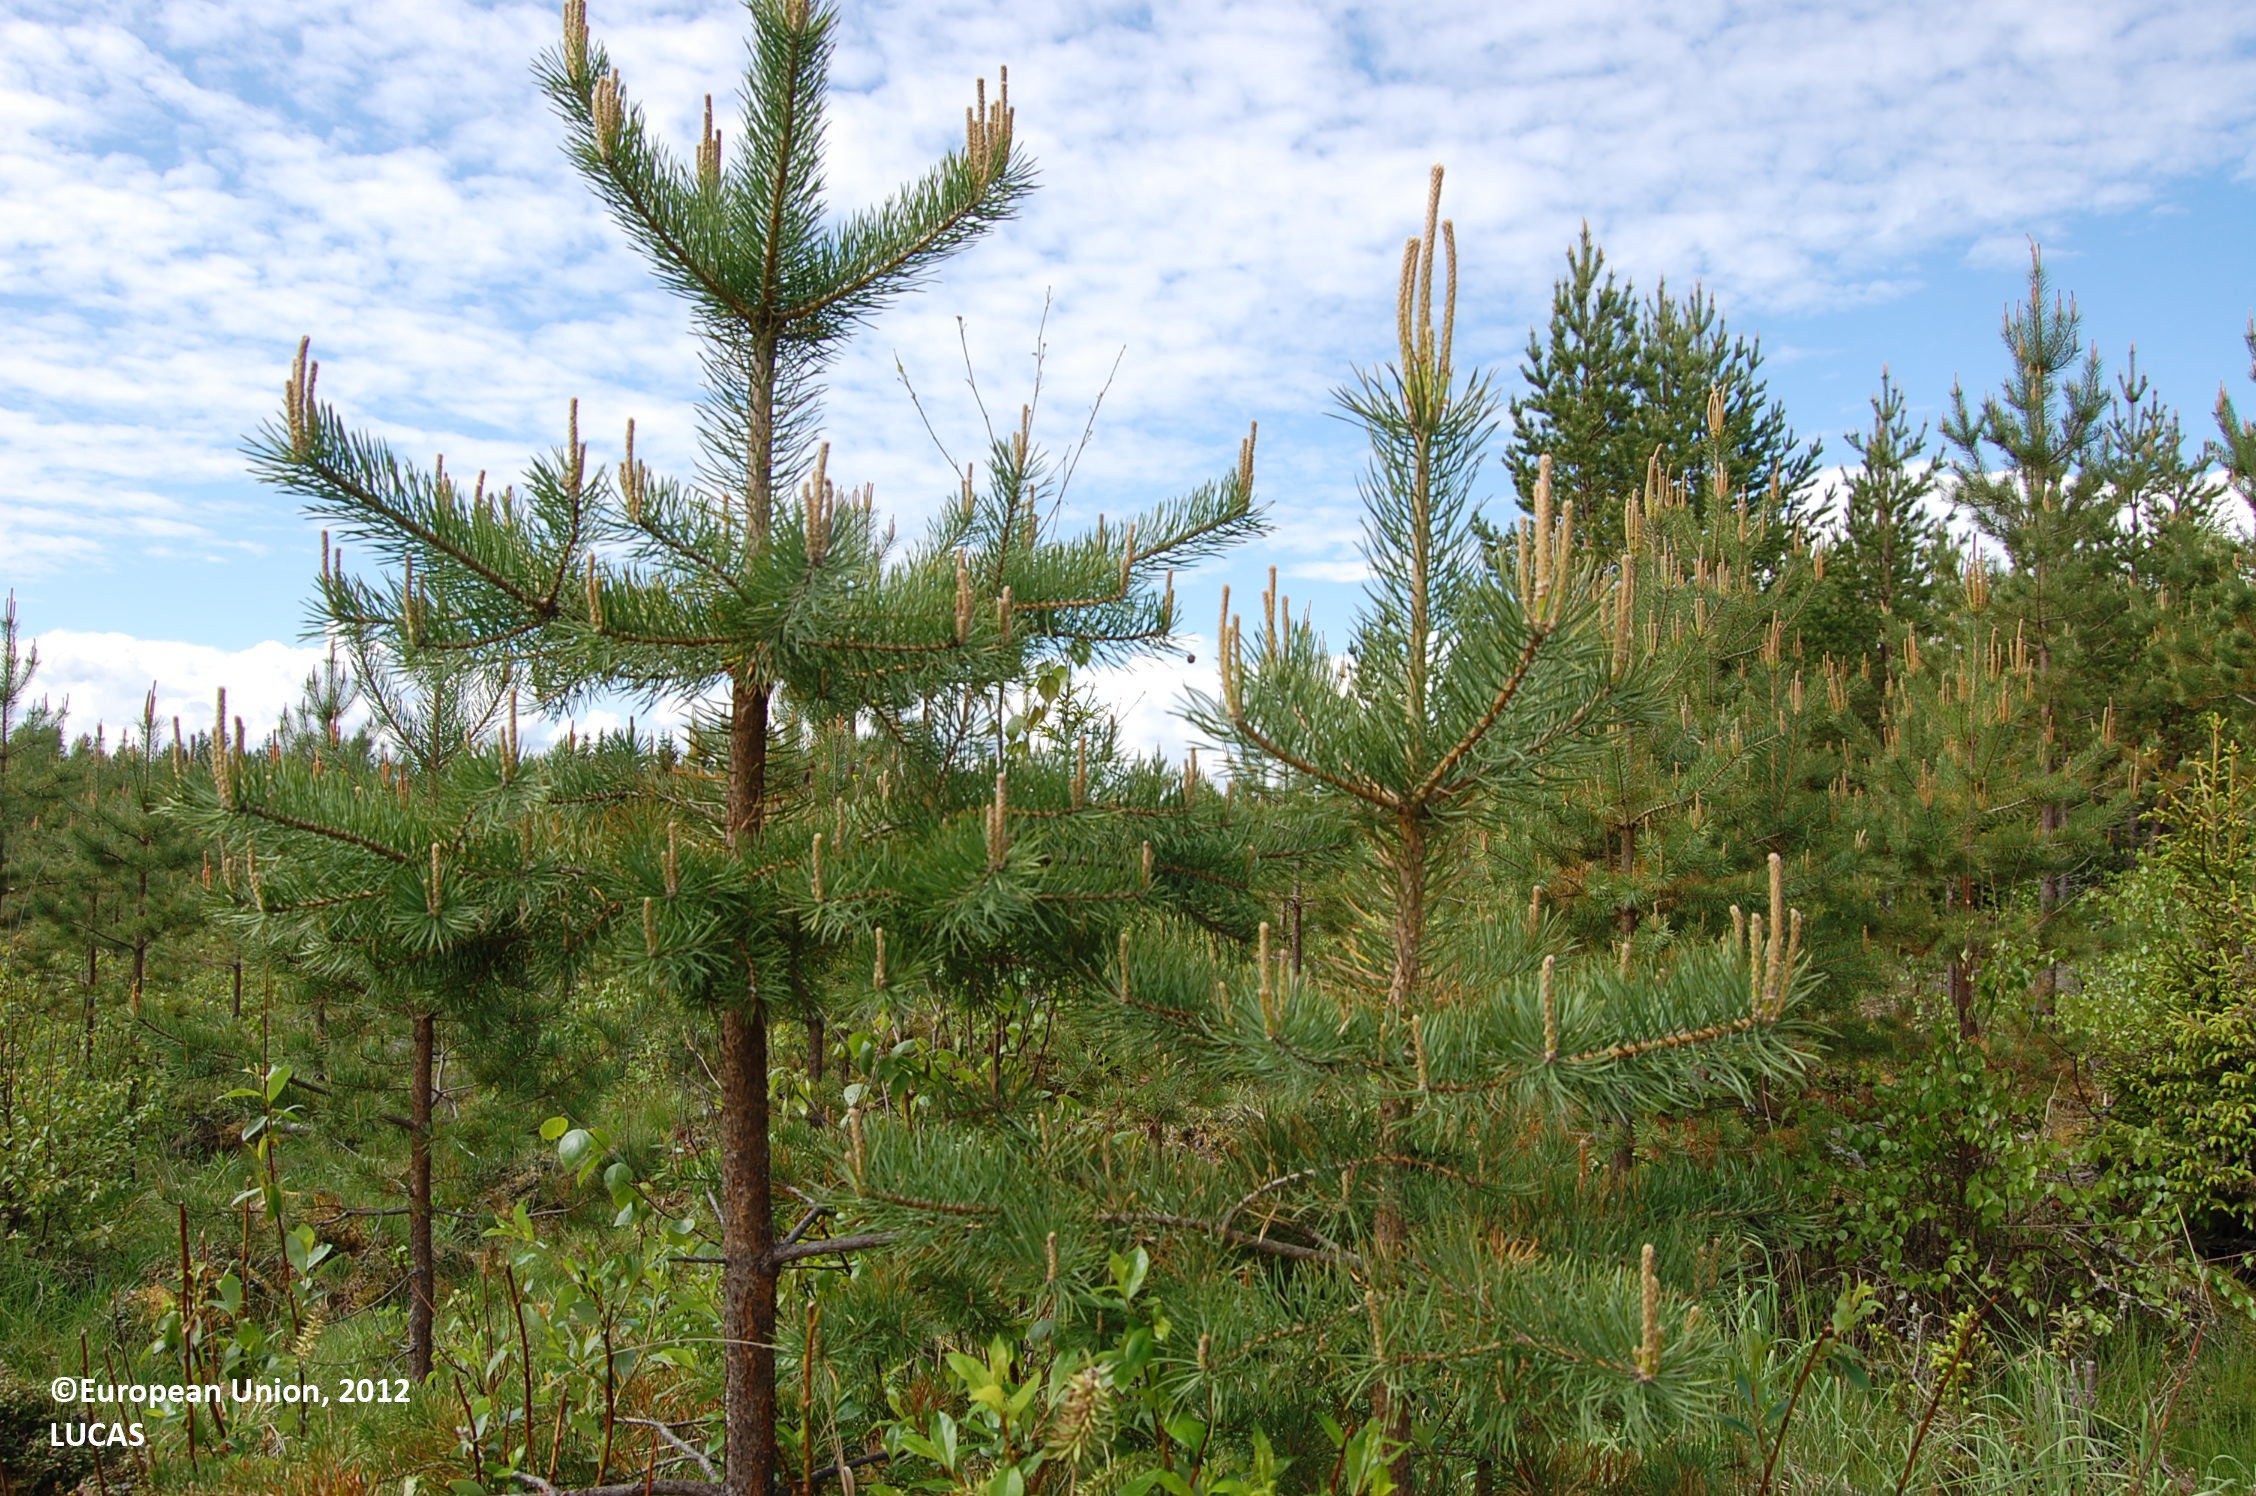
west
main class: Woodland
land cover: Pine dominated coniferous woodland
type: hemiboreal forest and nemoral coniferous forest and mixed broadleaved-coniferous forest
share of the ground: 25 - 50 %
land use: Forestry
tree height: < 5 m
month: June
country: FI
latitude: 63.9787
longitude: 26.0658
